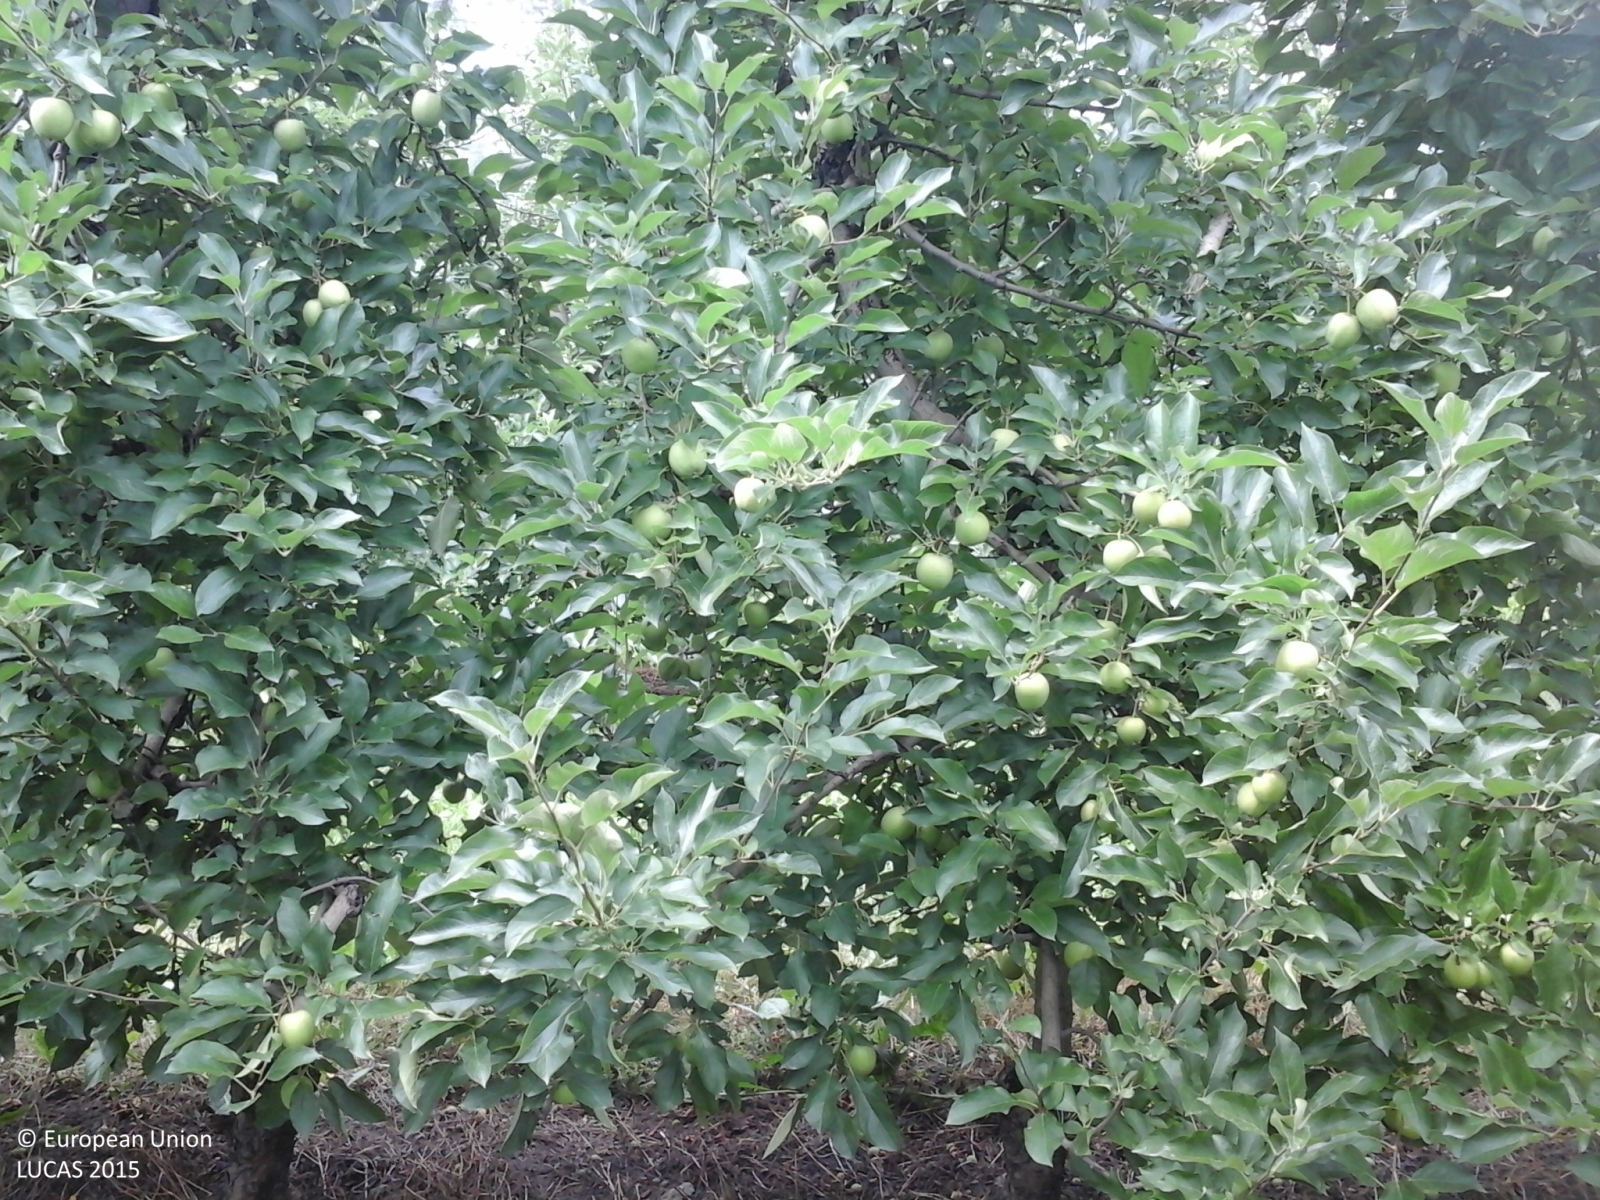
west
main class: Cropland
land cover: Apple fruit
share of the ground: 25 - 50 %
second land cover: Grassland without tree/shrub cover
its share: > 75 %
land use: Agriculture (excluding fallow land and kitchen gardens)
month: June
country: IT
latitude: 45.3896
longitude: 11.1858
